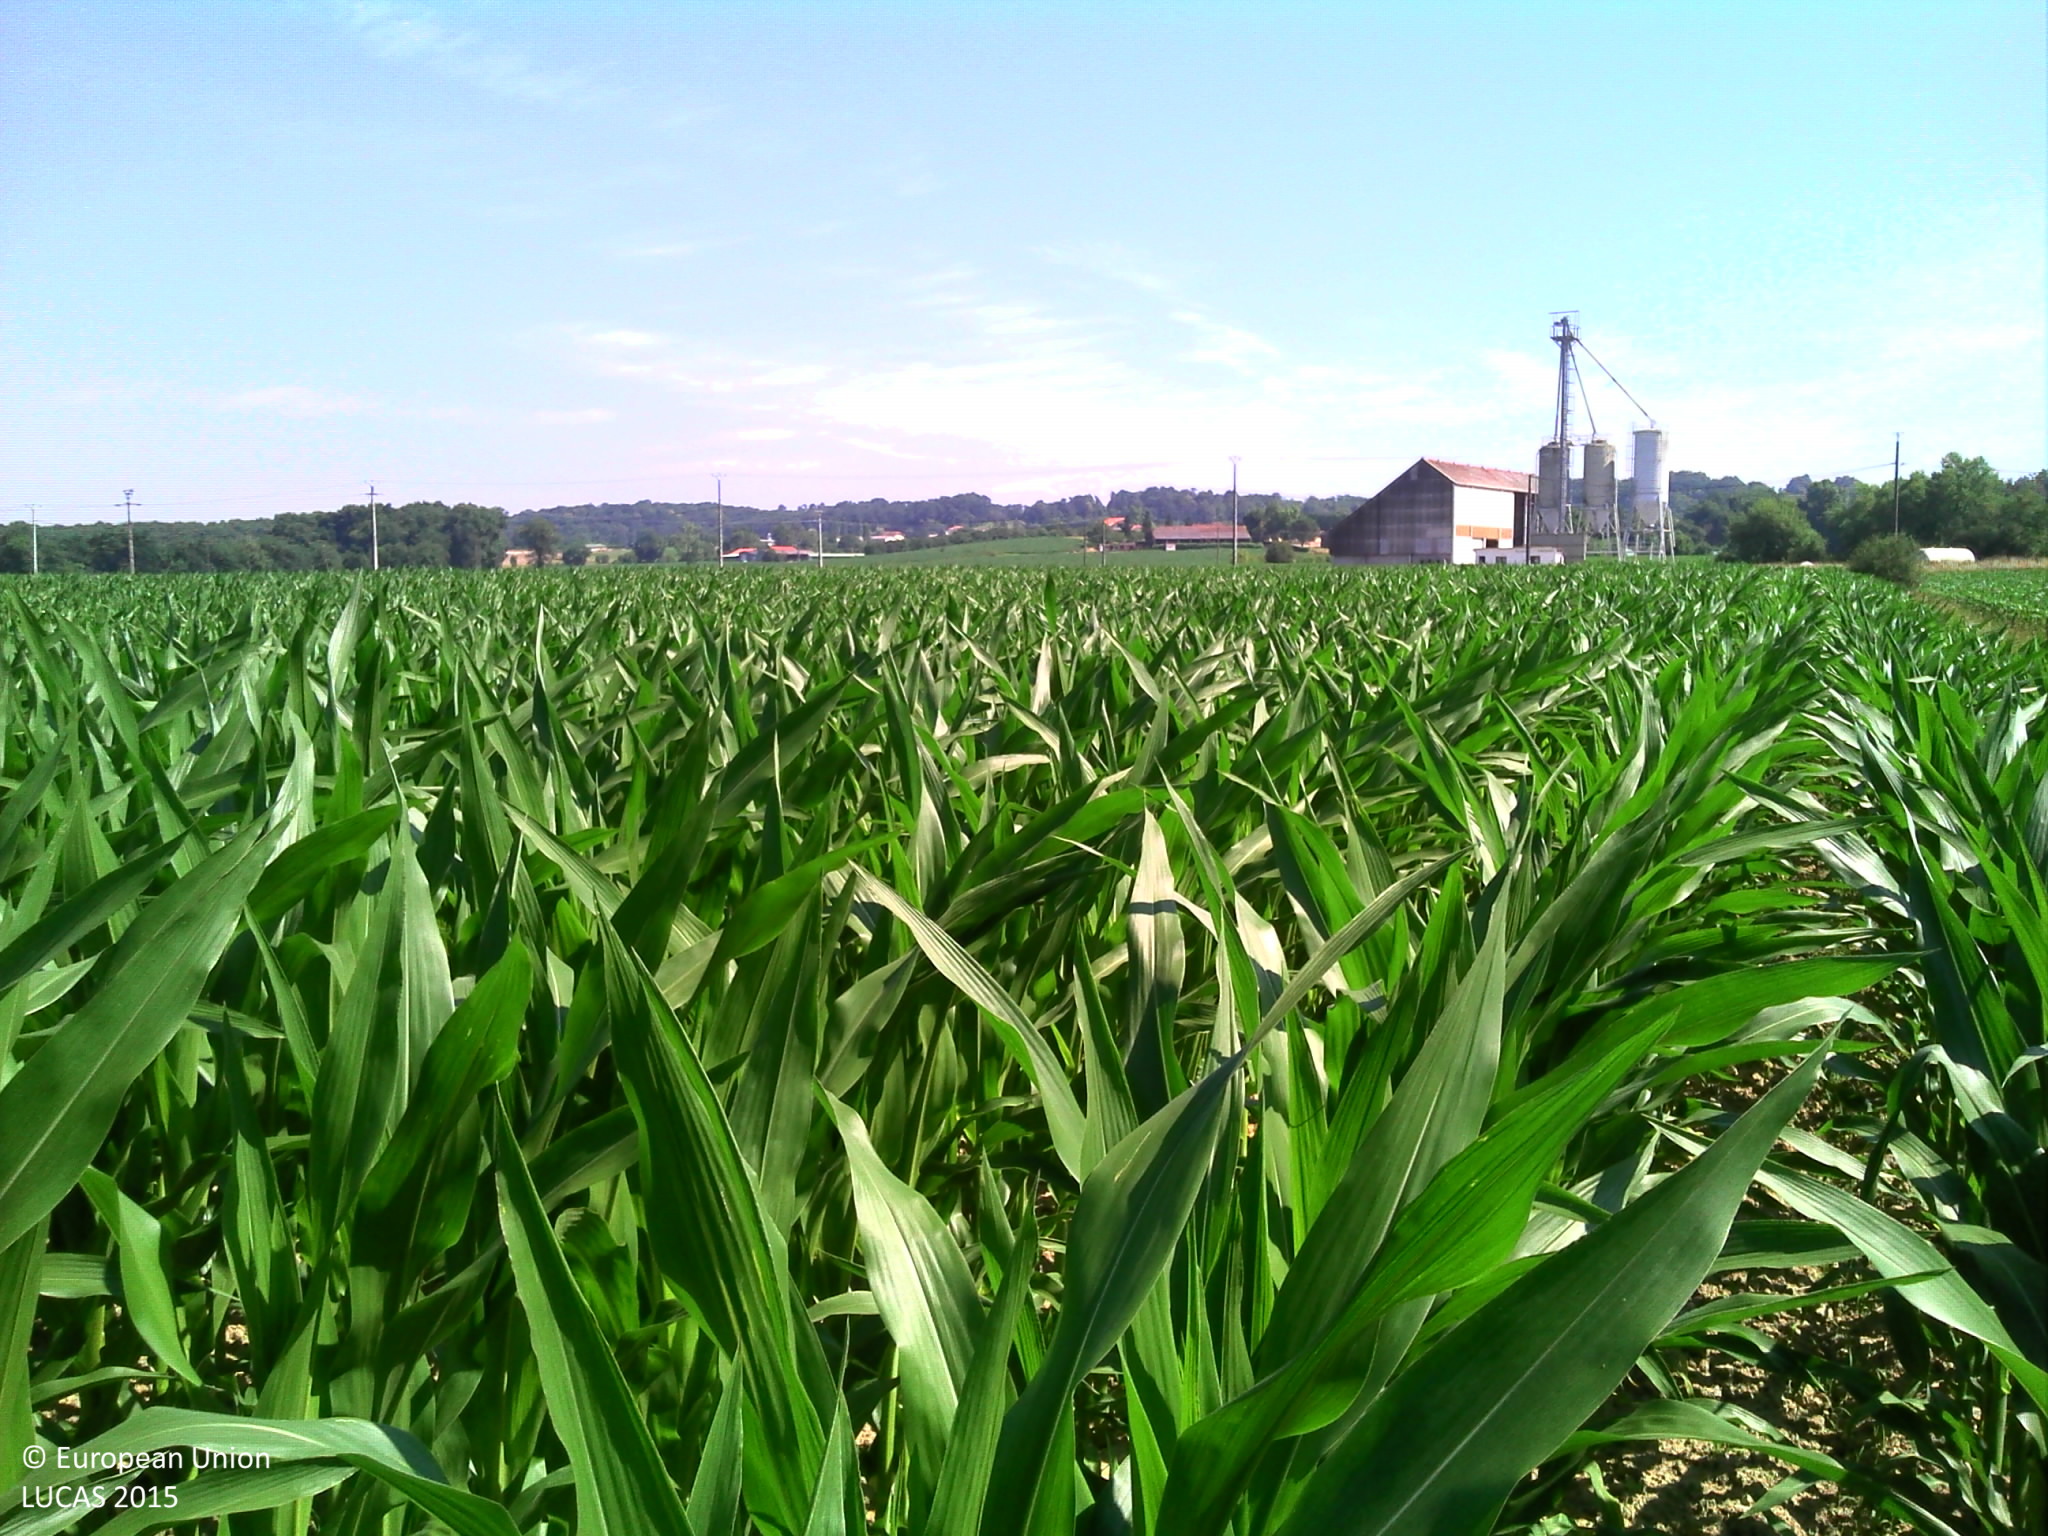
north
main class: Cropland
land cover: Maize
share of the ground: > 75 %
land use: Agriculture (excluding fallow land and kitchen gardens)
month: June
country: FR
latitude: 43.5777
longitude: -0.5234
